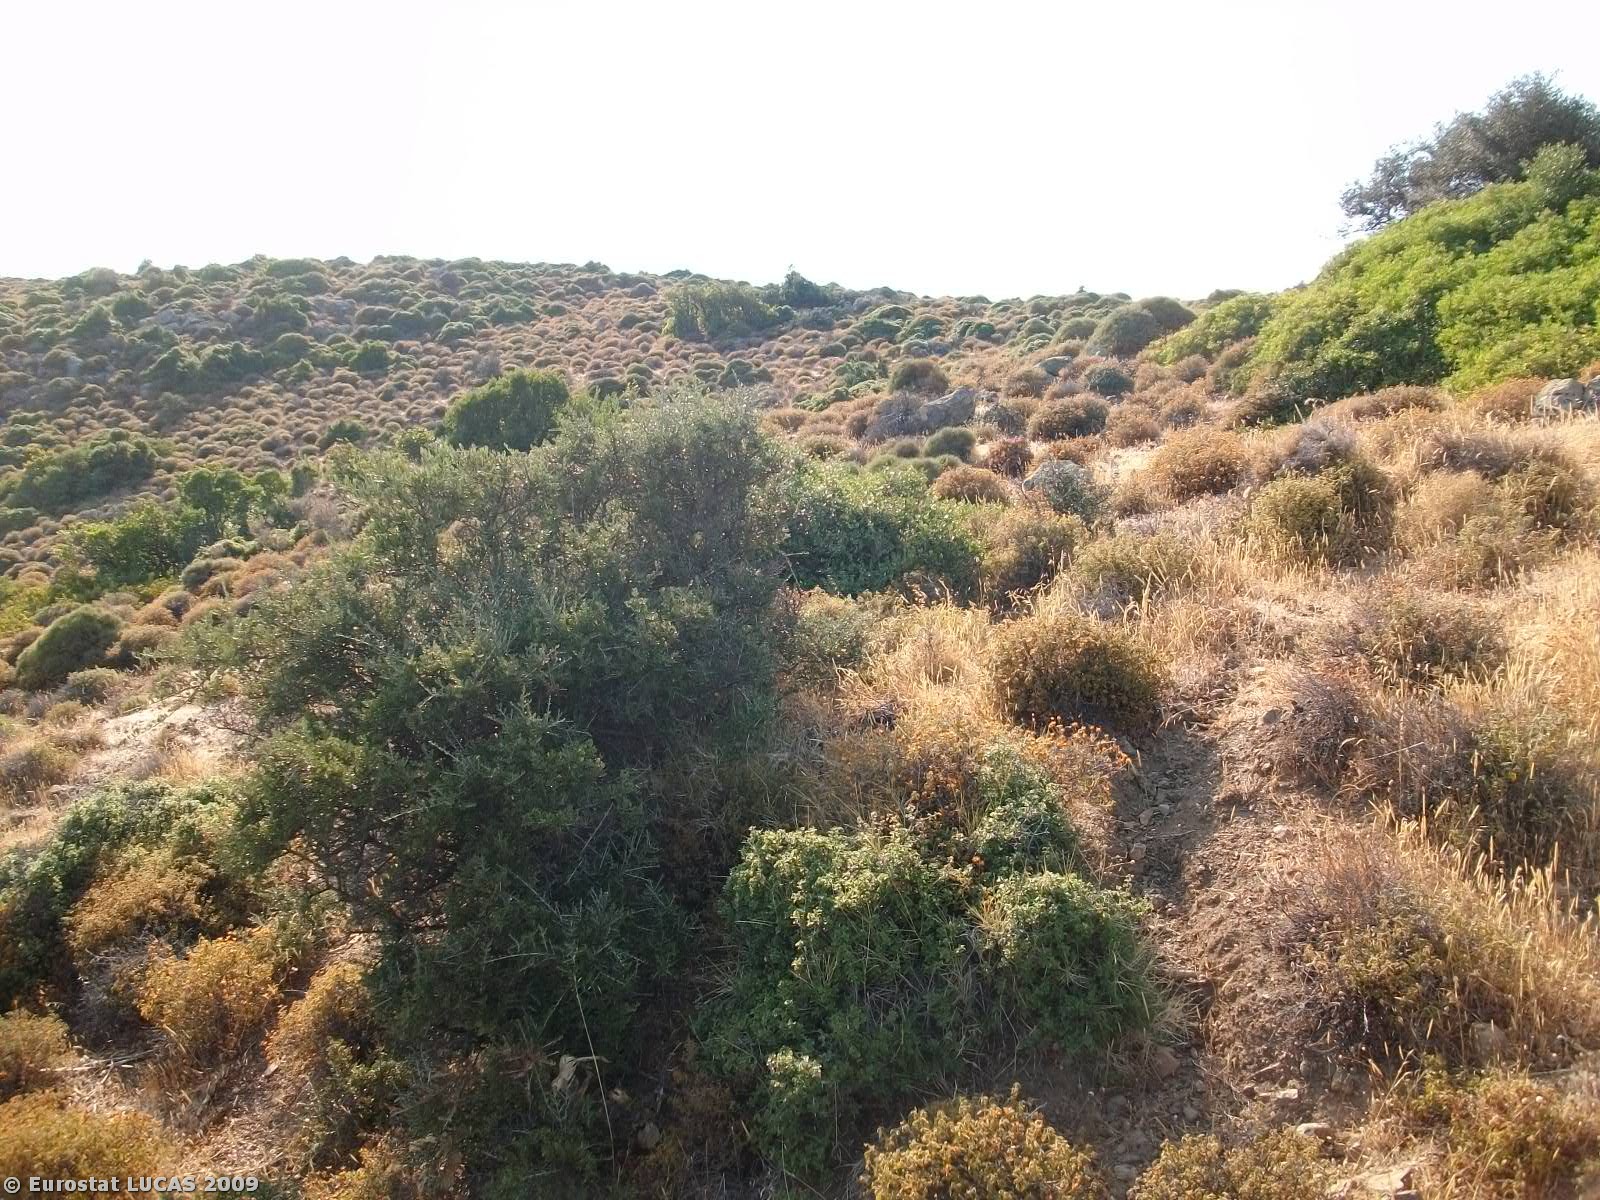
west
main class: Shrubland
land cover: Shrubland without tree cover
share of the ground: > 75 %
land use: Unused
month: August
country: GR
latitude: 37.4664
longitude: 23.3216
